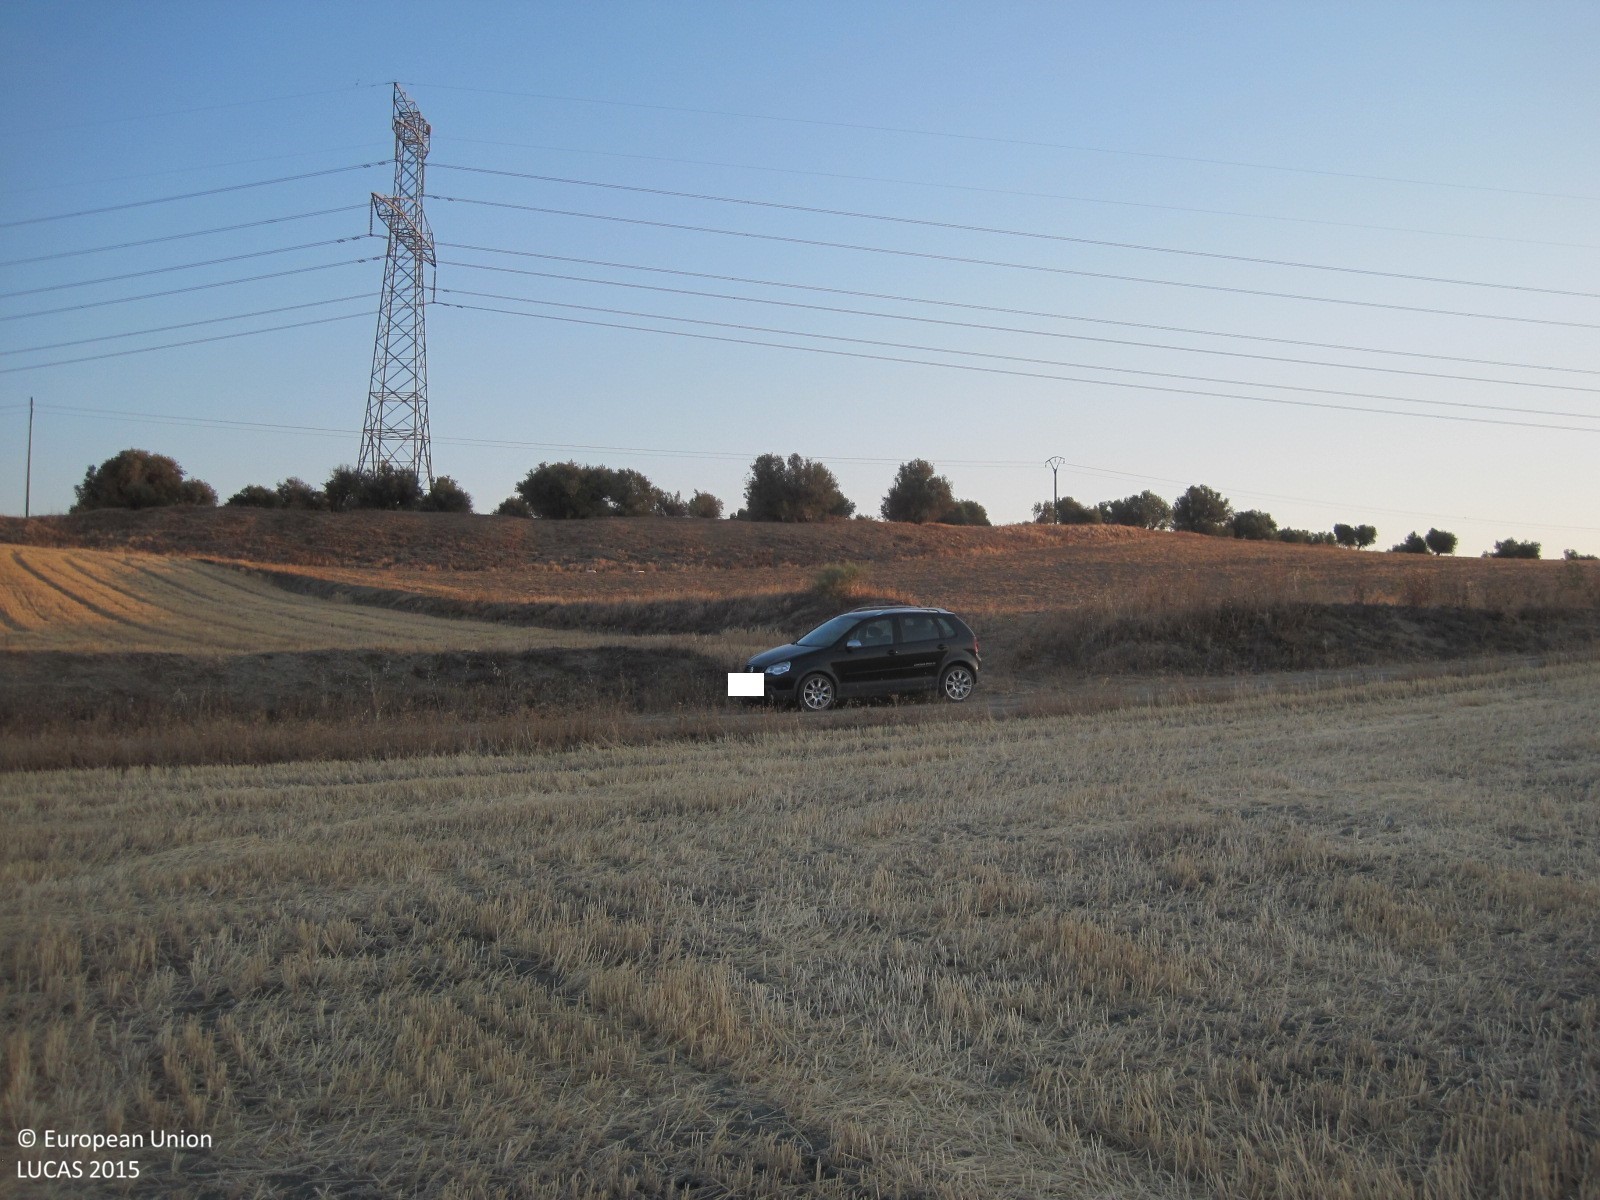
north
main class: Cropland
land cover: Barley
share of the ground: < 10 %
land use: Agriculture (excluding fallow land and kitchen gardens)
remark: Harvested field
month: July
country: ES
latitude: 40.1087
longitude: -3.8200
